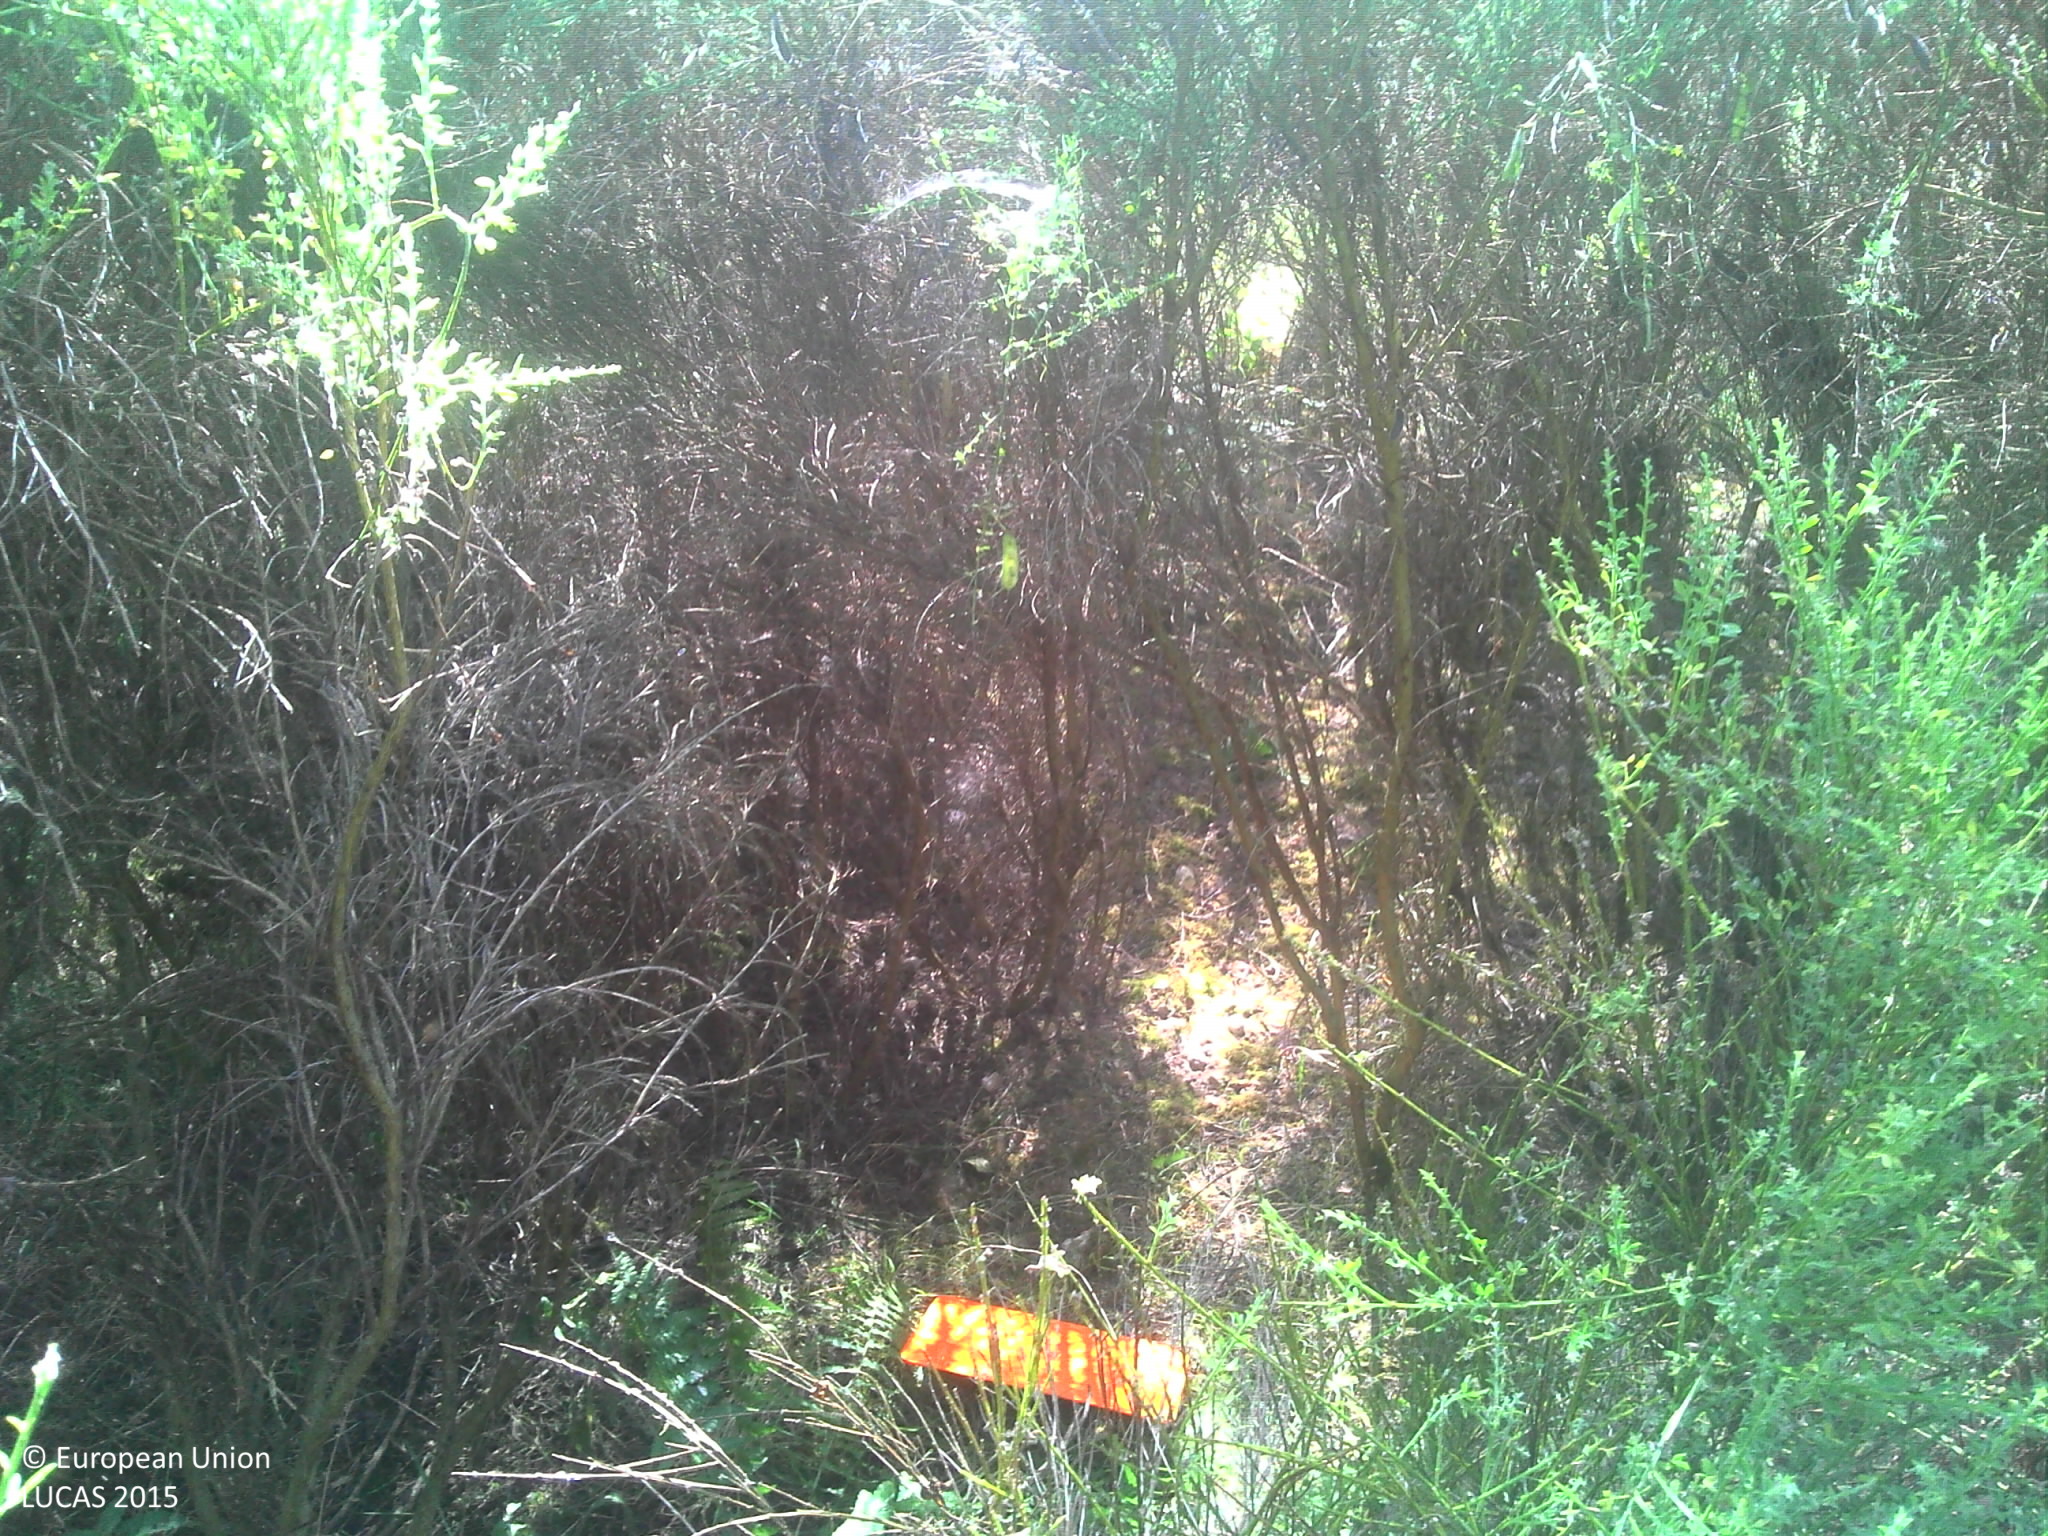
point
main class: Woodland
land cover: Pine dominated coniferous woodland
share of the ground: > 75 %
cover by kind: coniferous forest trees 50 %, lichens and mosses 20 %, unconsolidated bare surface 20 %, herbaceous plants 10 %
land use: Forestry
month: June
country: FR
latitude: 47.2806
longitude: 1.5127
